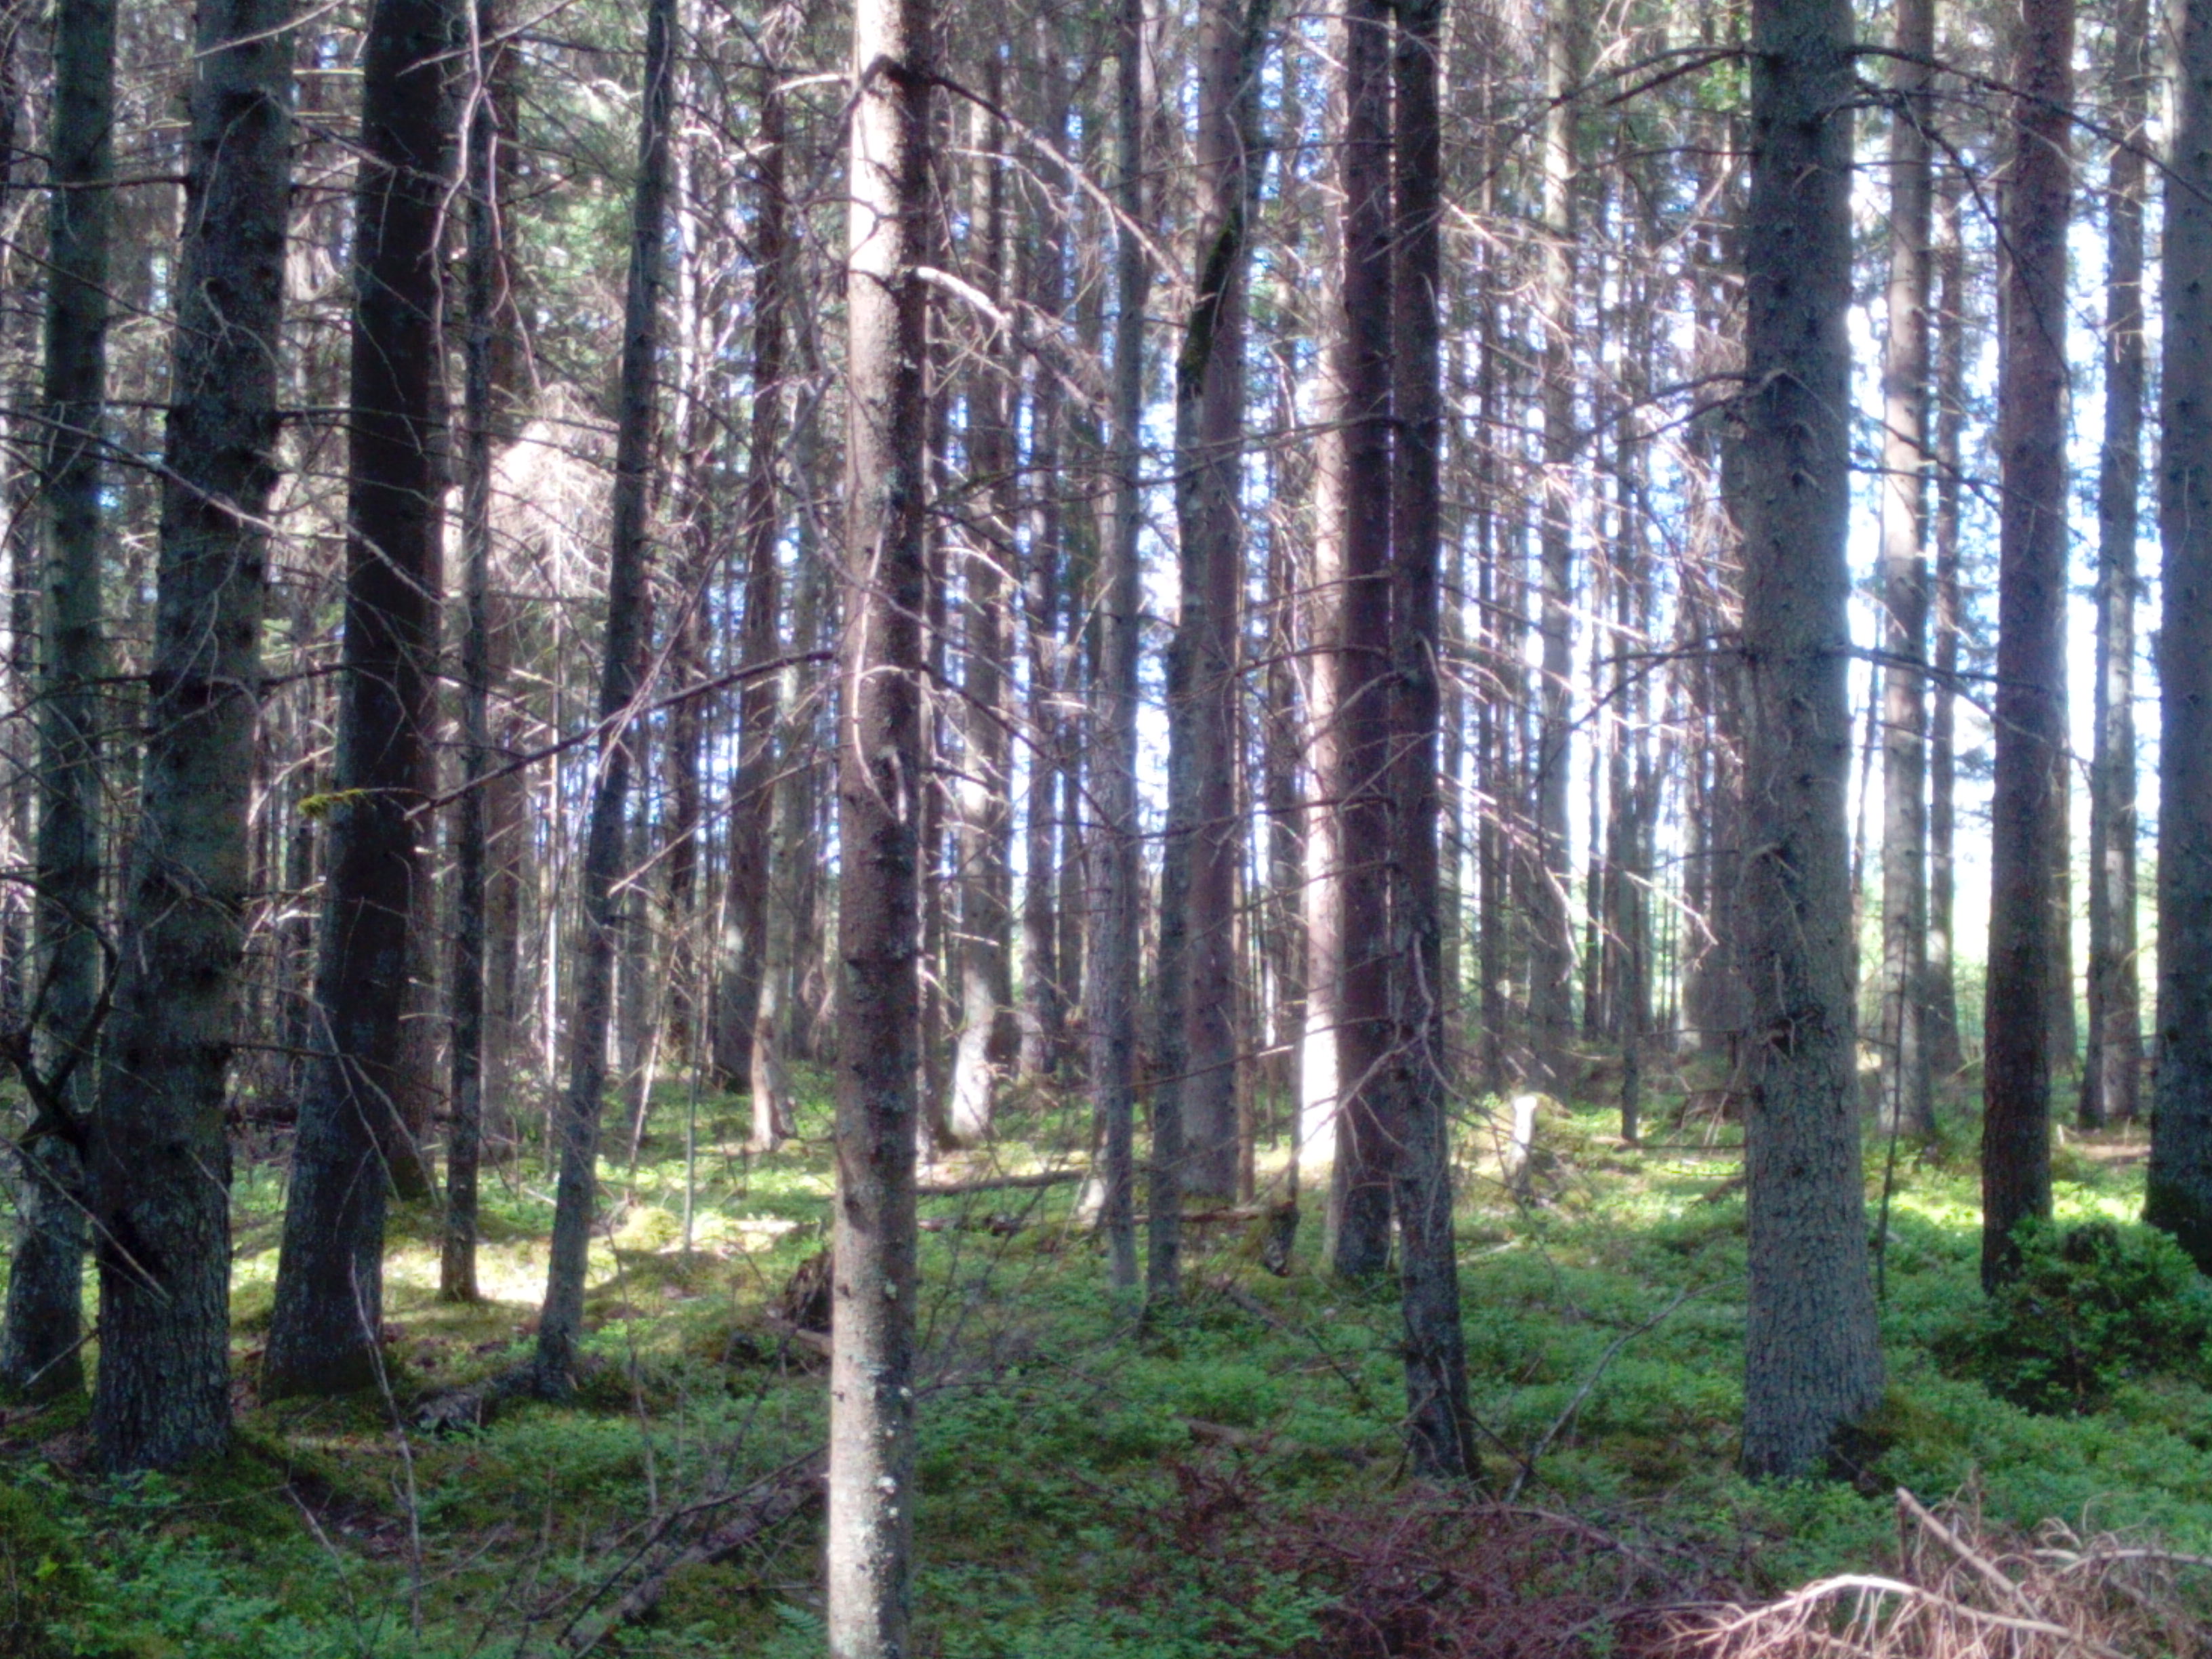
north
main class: Woodland
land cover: Spruce dominated coniferous woodland
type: hemiboreal forest and nemoral coniferous forest and mixed broadleaved-coniferous forest
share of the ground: > 75 %
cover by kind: coniferous forest trees 90 %, herbaceous plants 5 %, lichens and mosses 5 %
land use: Forestry
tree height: > 5 m
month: May
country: LV
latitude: 56.5550
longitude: 22.3374
